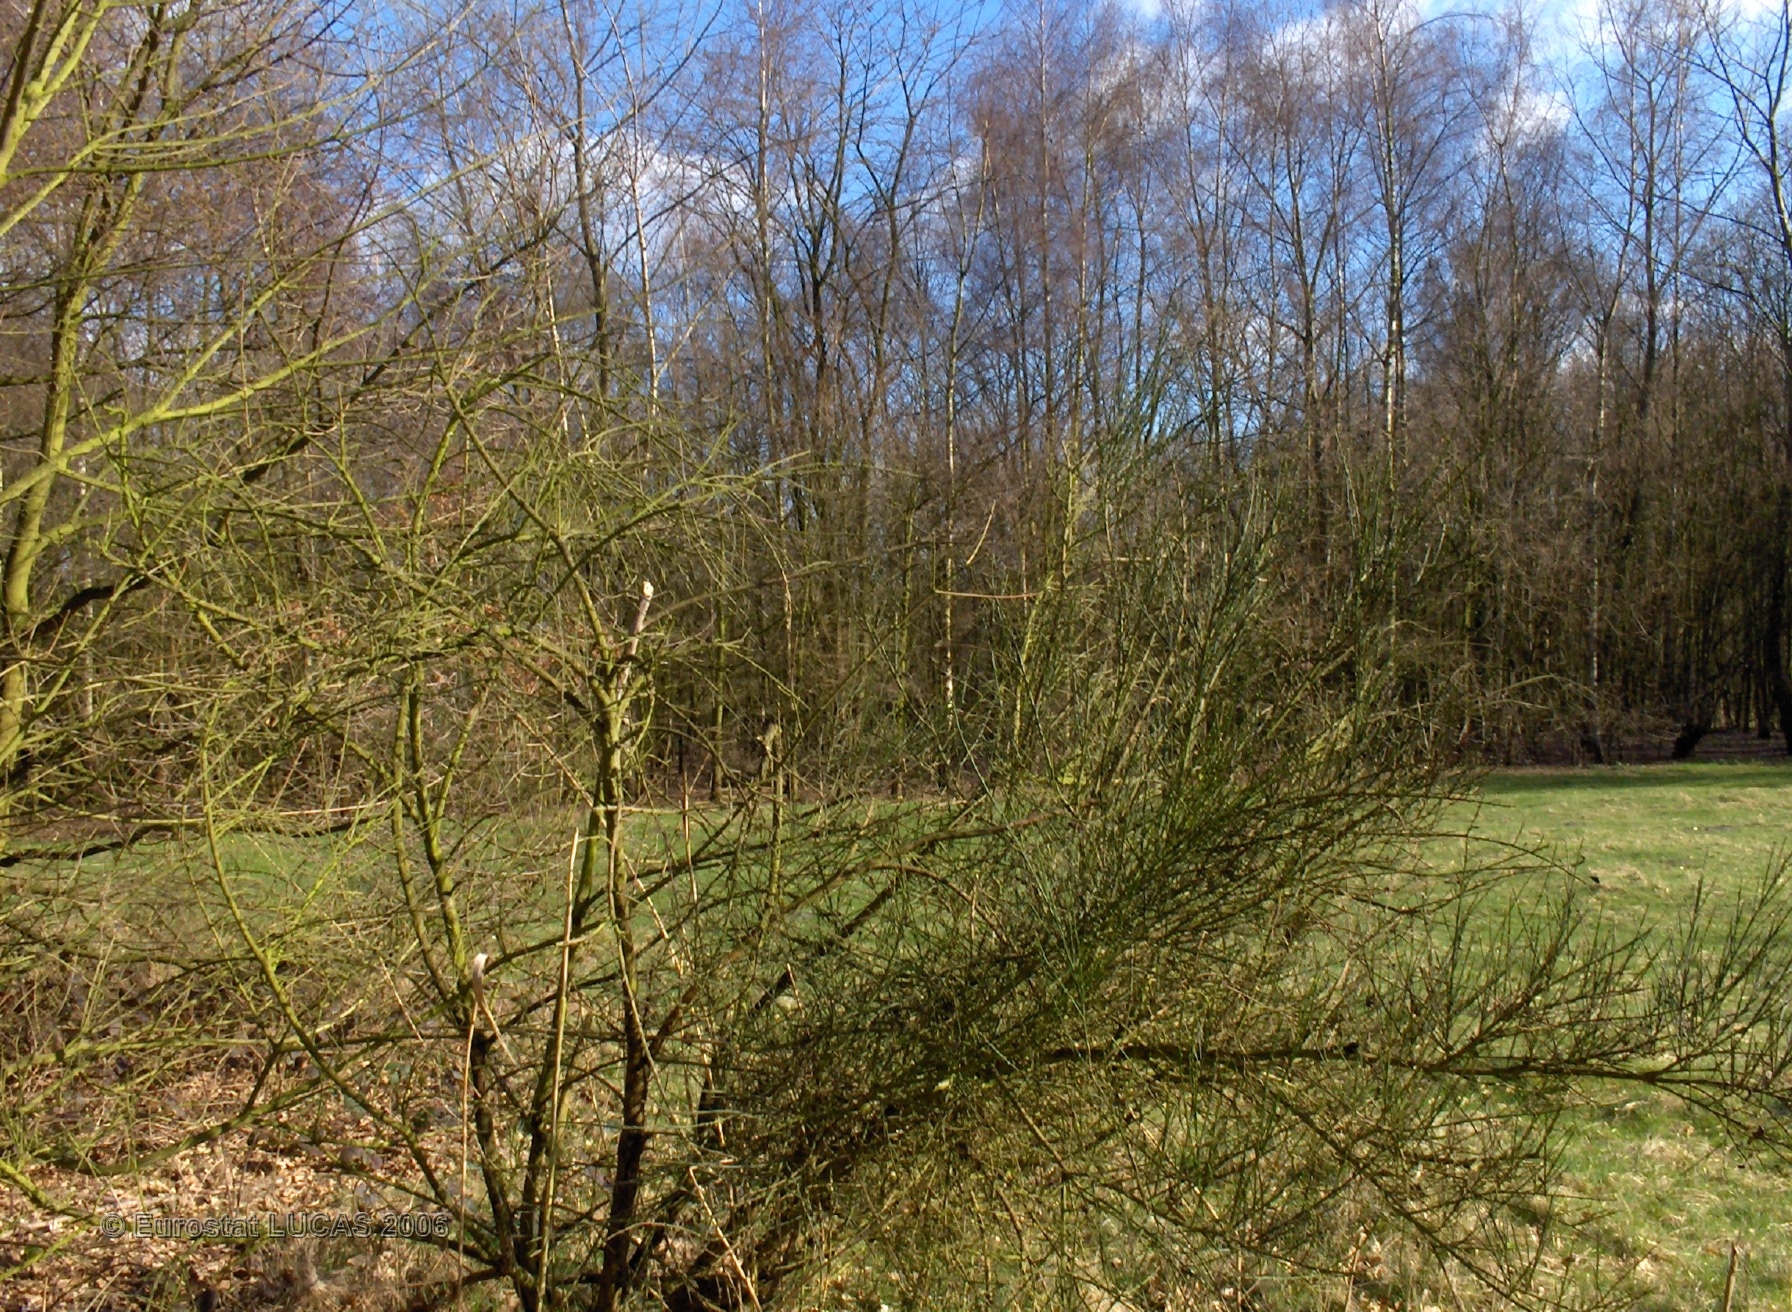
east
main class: Grassland
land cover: Grassland with sparse tree/shrub cover
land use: Agriculture (excluding fallow land and kitchen gardens)
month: April
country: BE
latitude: 51.1657
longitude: 4.4325
